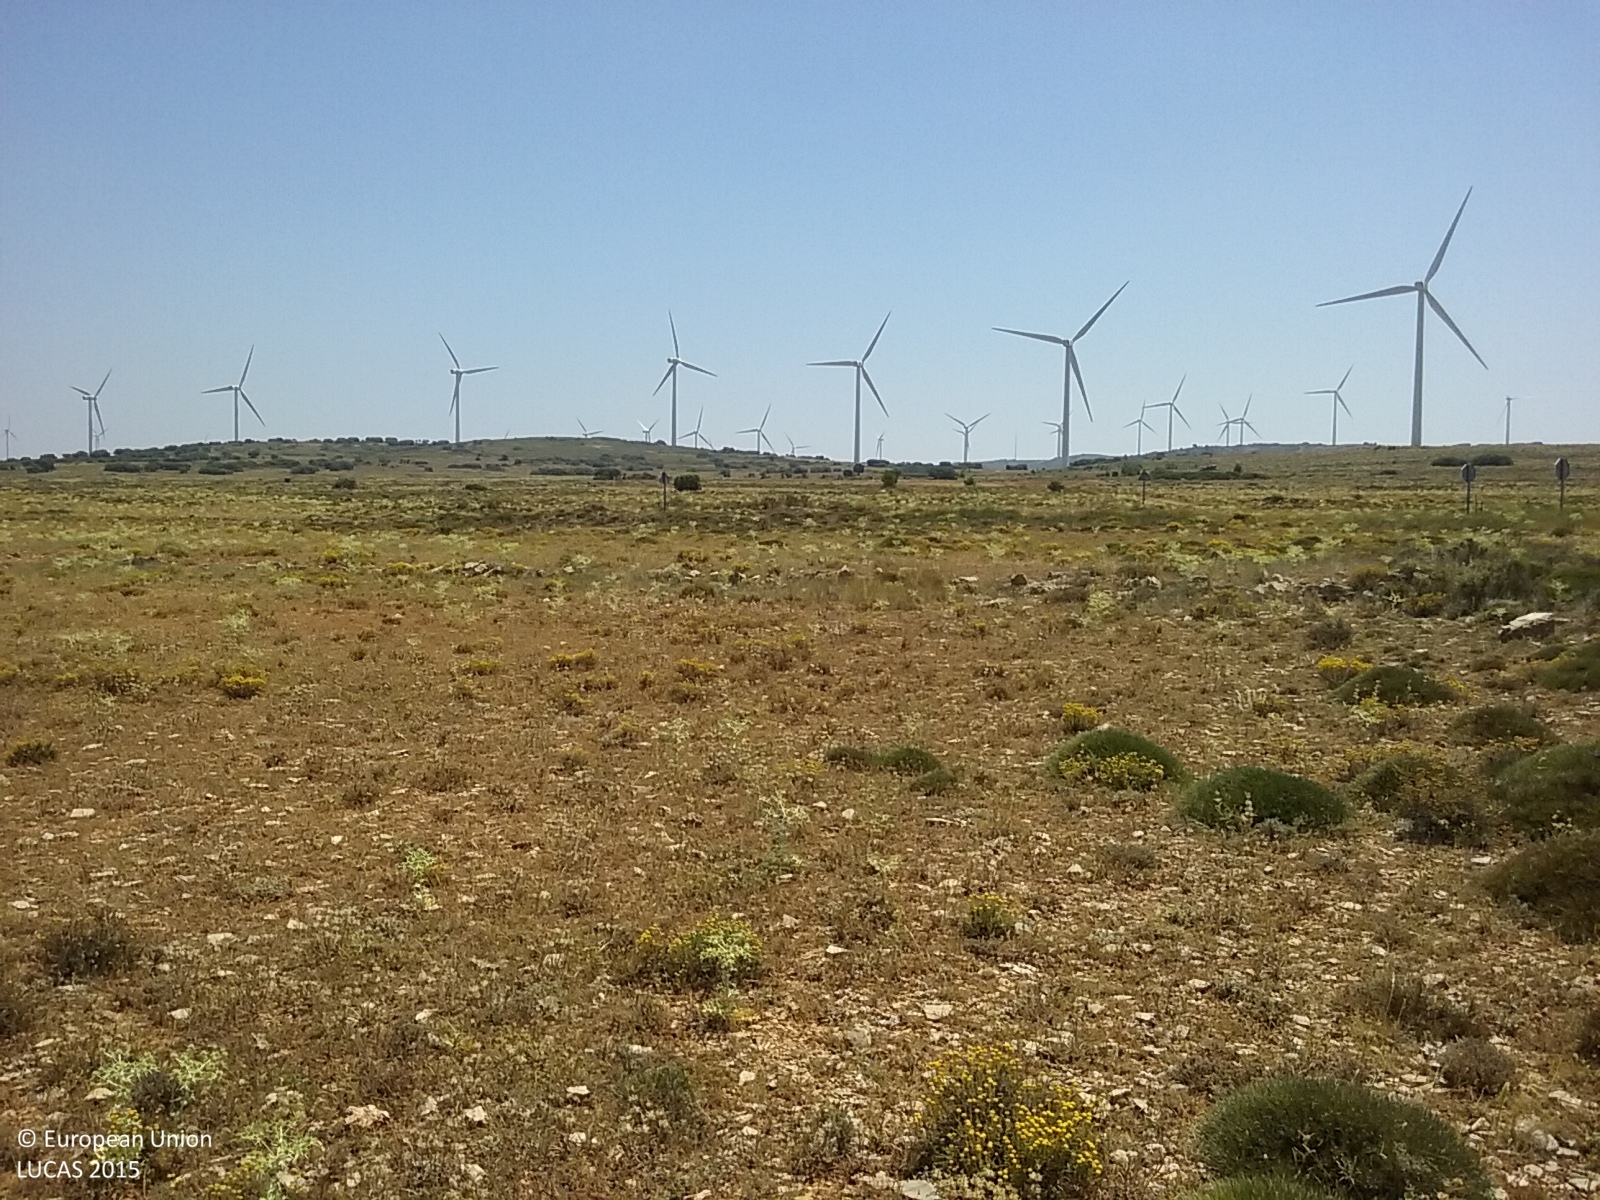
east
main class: Grassland
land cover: Spontaneously vegetated surfaces
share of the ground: 50 - 75 %
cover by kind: herbaceous plants 75 %, unconsolidated bare surface 20 %, shrubs 5 %
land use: Semi-natural and natural areas not in use
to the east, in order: Spontaneously vegetated surfaces; Dry stone walls; Grassland without tree/shrub cover; Tracks; Grassland without tree/shrub cover; Dry stone walls; Grassland without tree/shrub cover; Dry stone walls; Grassland without tree/shrub cover; Dry stone walls; Grassland without tree/shrub cover
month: July
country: ES
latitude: 39.9729
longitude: -0.6941
